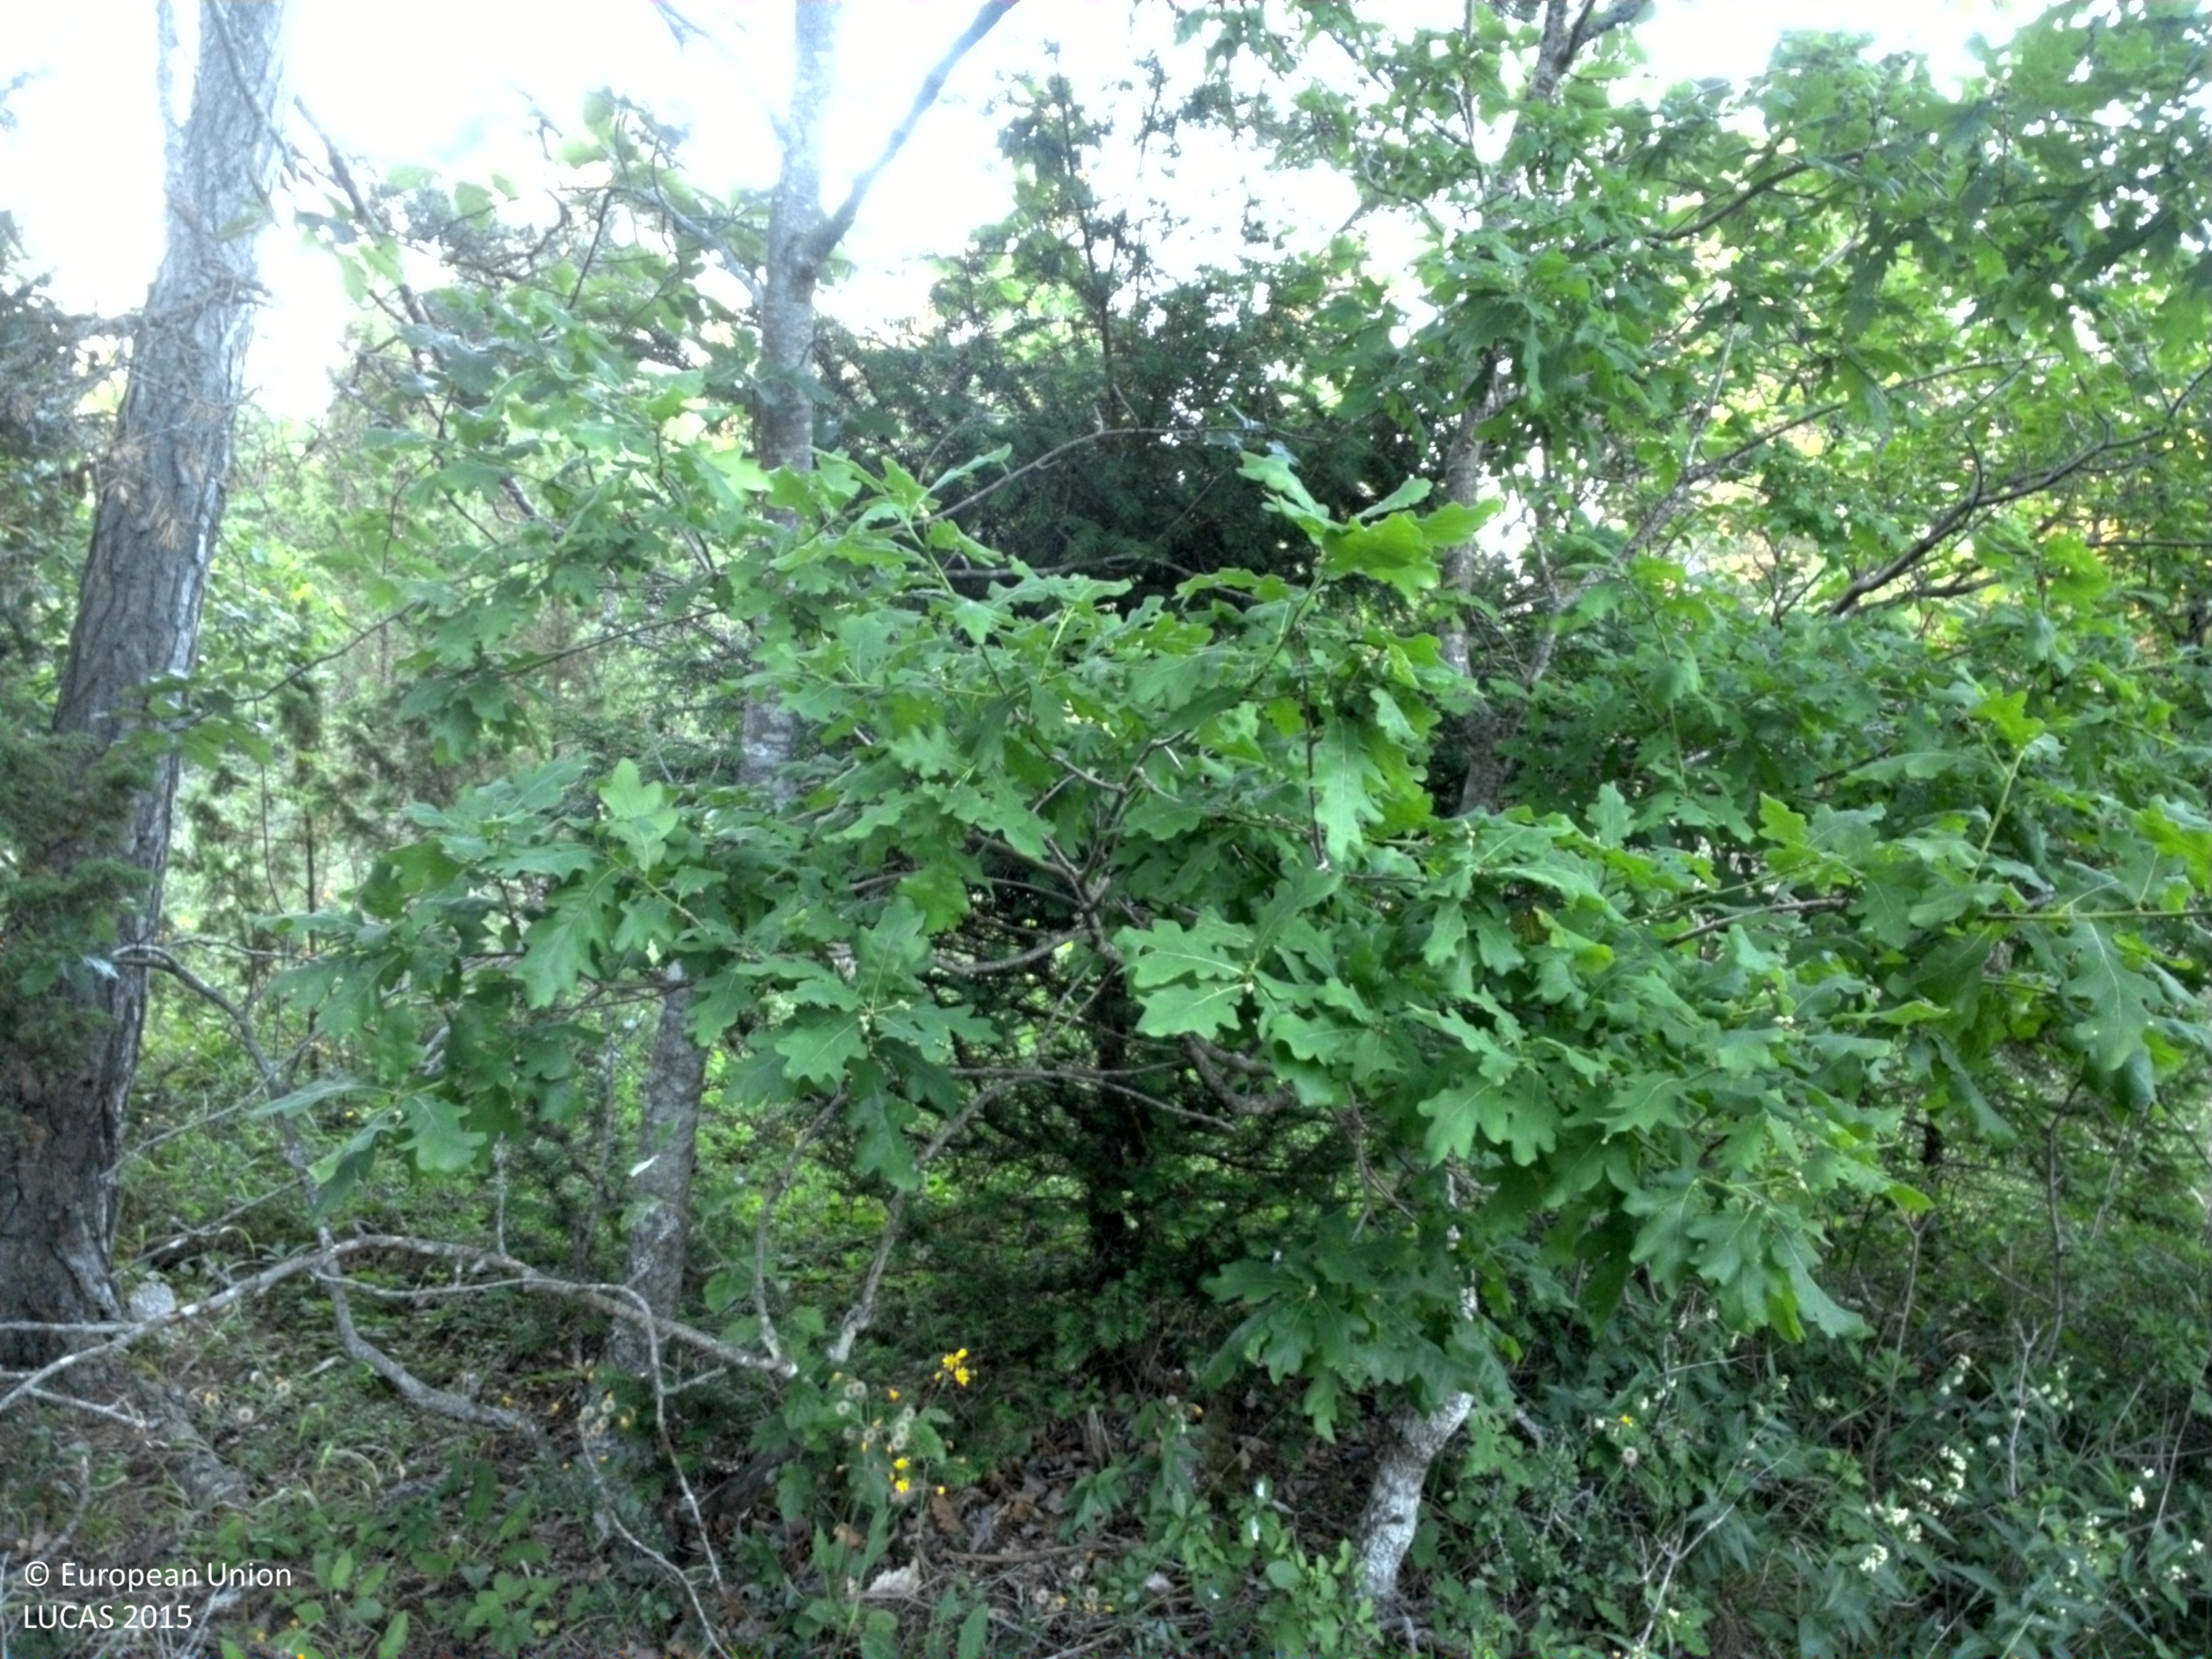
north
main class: Woodland
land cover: Pine dominated coniferous woodland
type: hemiboreal forest and nemoral coniferous forest and mixed broadleaved-coniferous forest
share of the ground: > 75 %
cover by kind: coniferous forest trees 80 %, herbaceous plants 10 %, broadleaved forest trees 5 %, shrubs 5 %
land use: Forestry
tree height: > 5 m
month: July
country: SE
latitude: 57.7497
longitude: 18.7972
